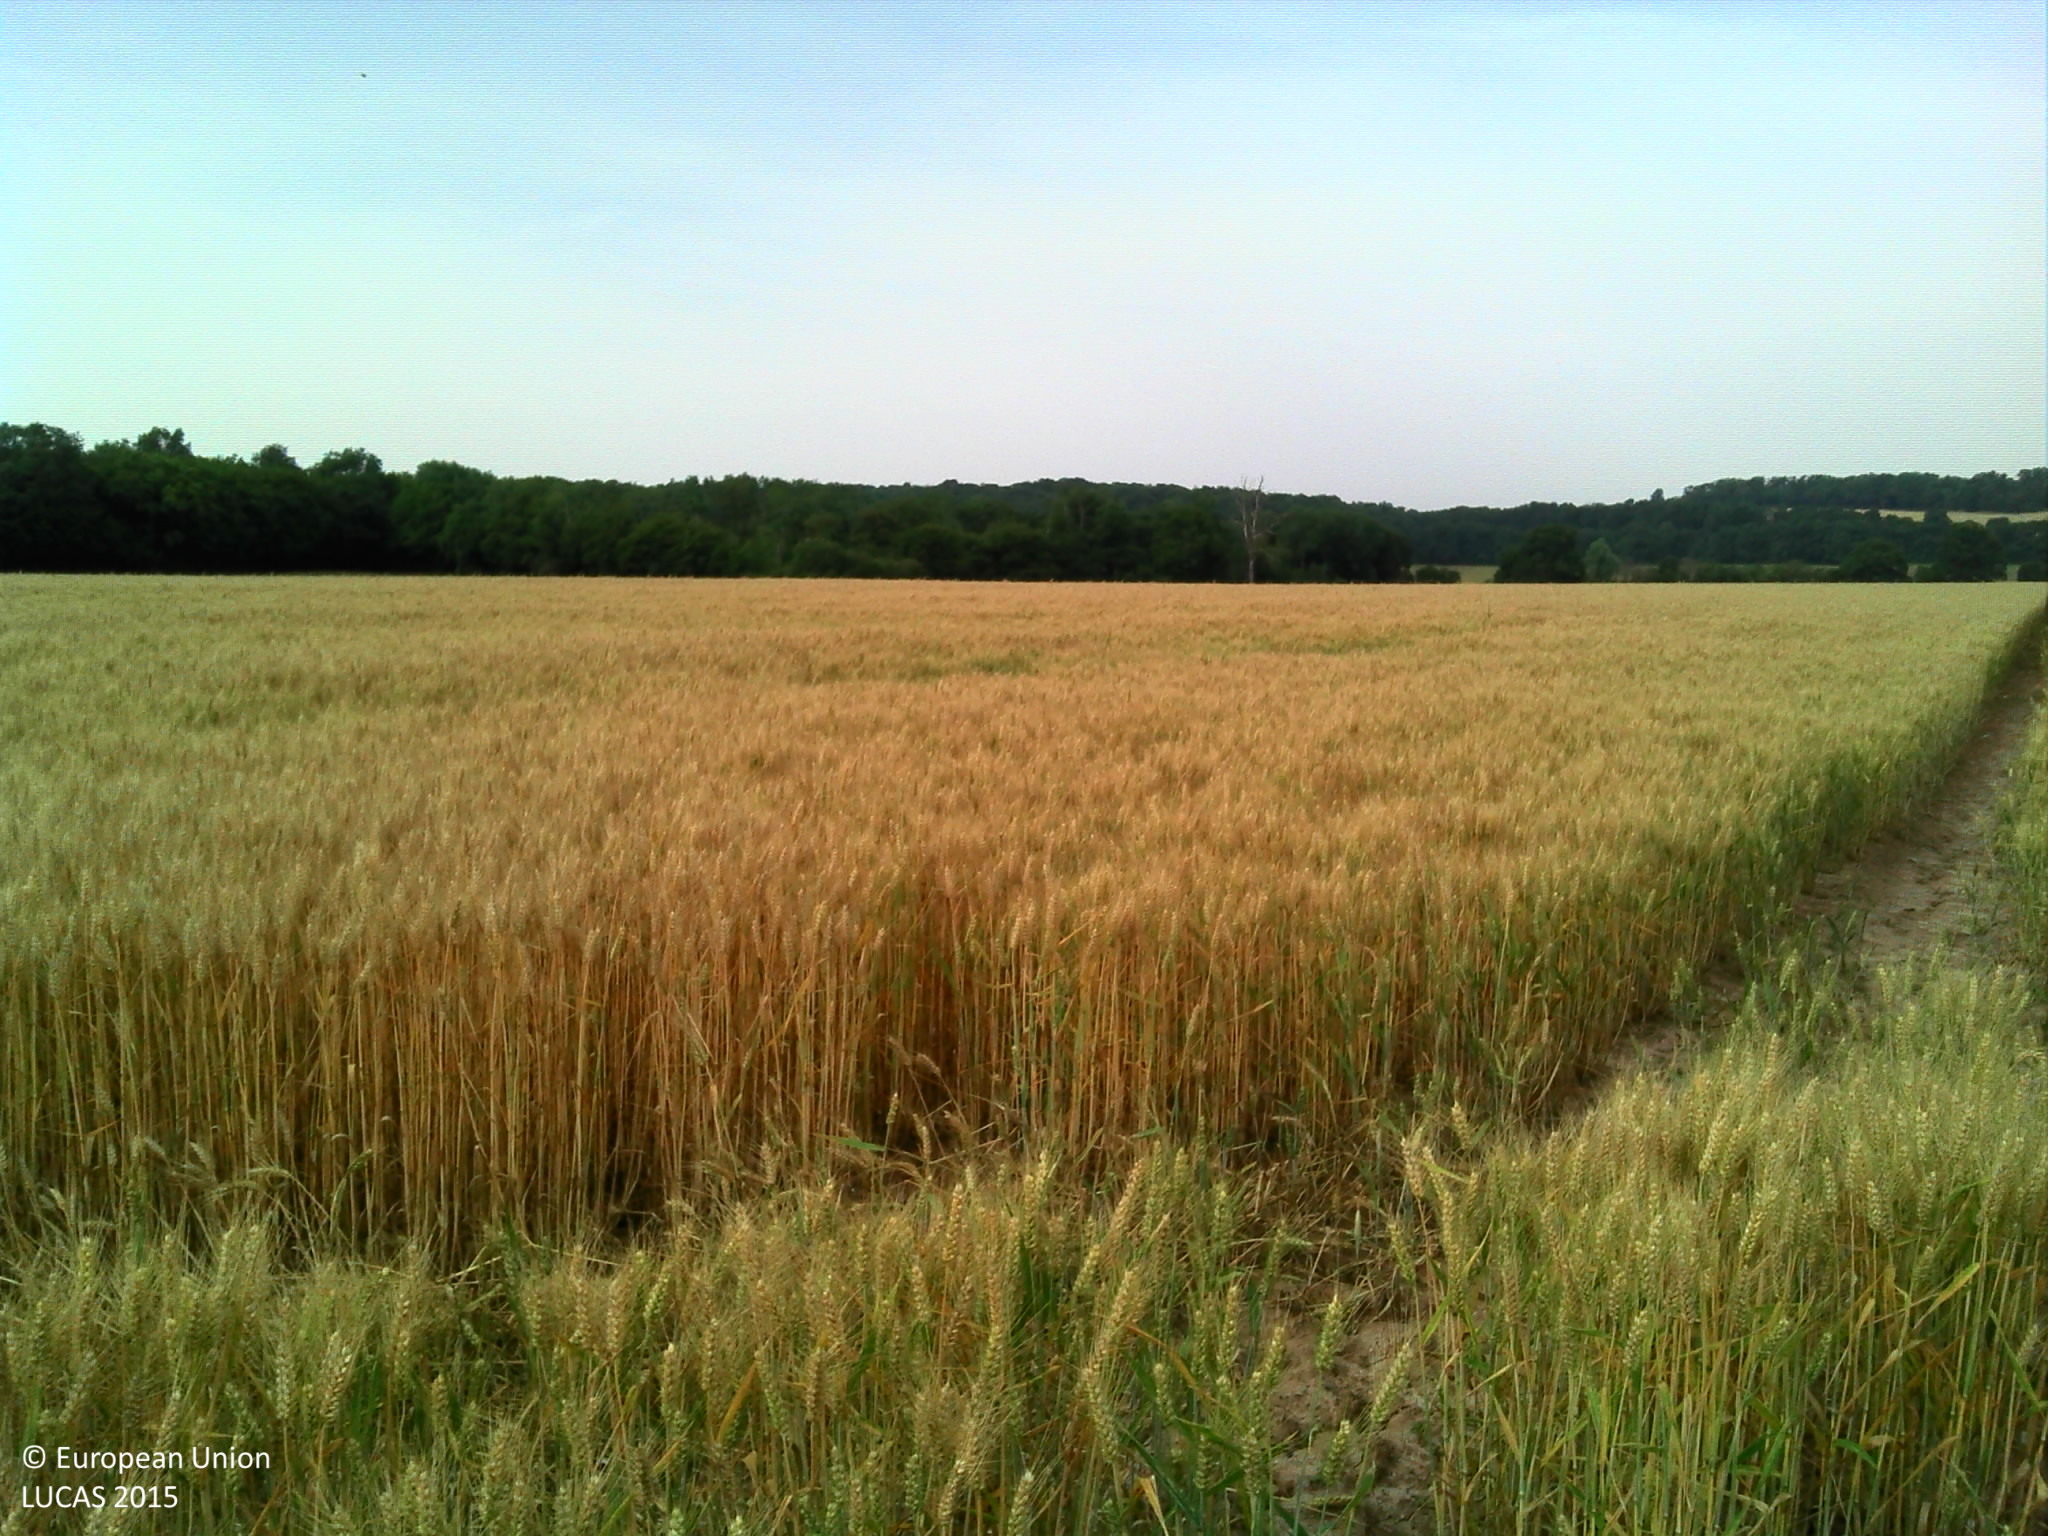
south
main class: Cropland
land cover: Common wheat
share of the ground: > 75 %
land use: Agriculture (excluding fallow land and kitchen gardens)
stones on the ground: < 10 %
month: July
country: FR
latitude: 47.0976
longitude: 3.5812
